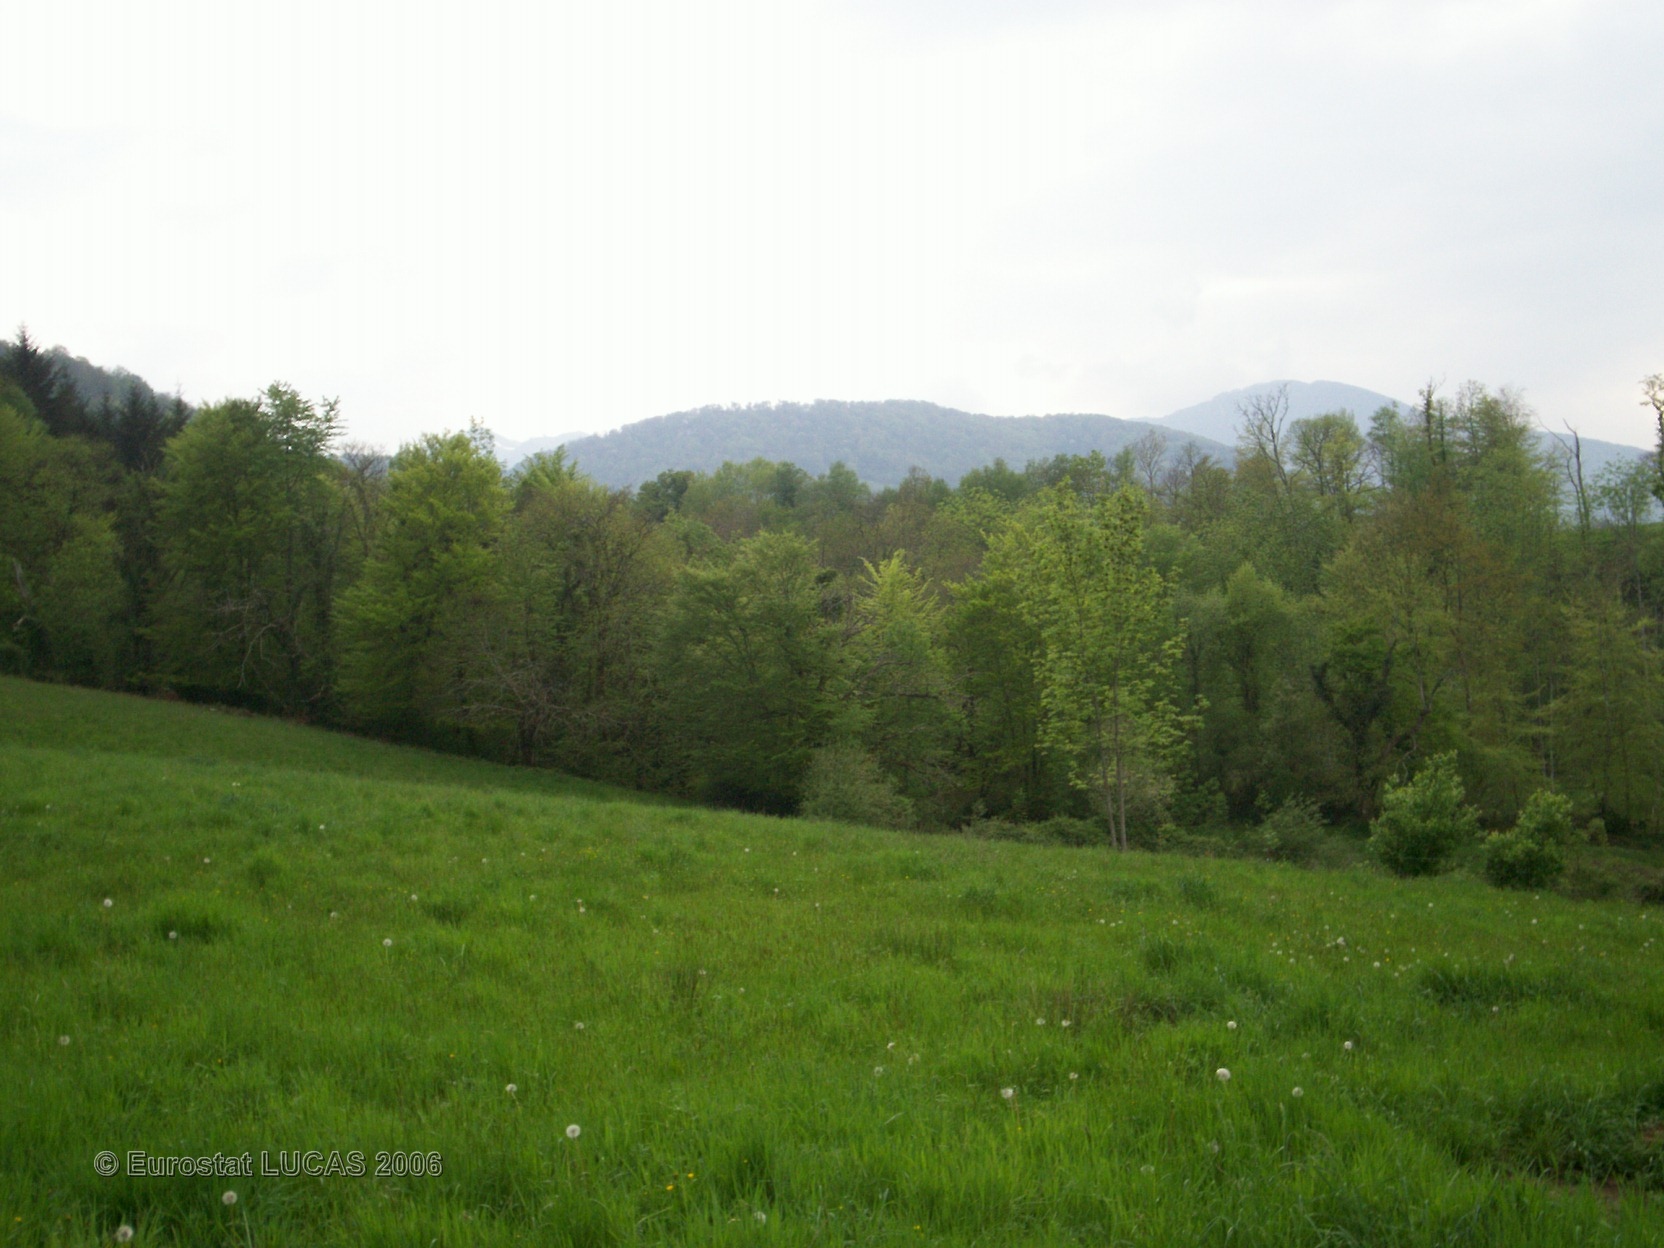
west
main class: Grassland
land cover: Grassland without tree/shrub cover
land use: Agriculture (excluding fallow land and kitchen gardens)
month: April
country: FR
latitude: 43.0920
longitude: -0.1140
